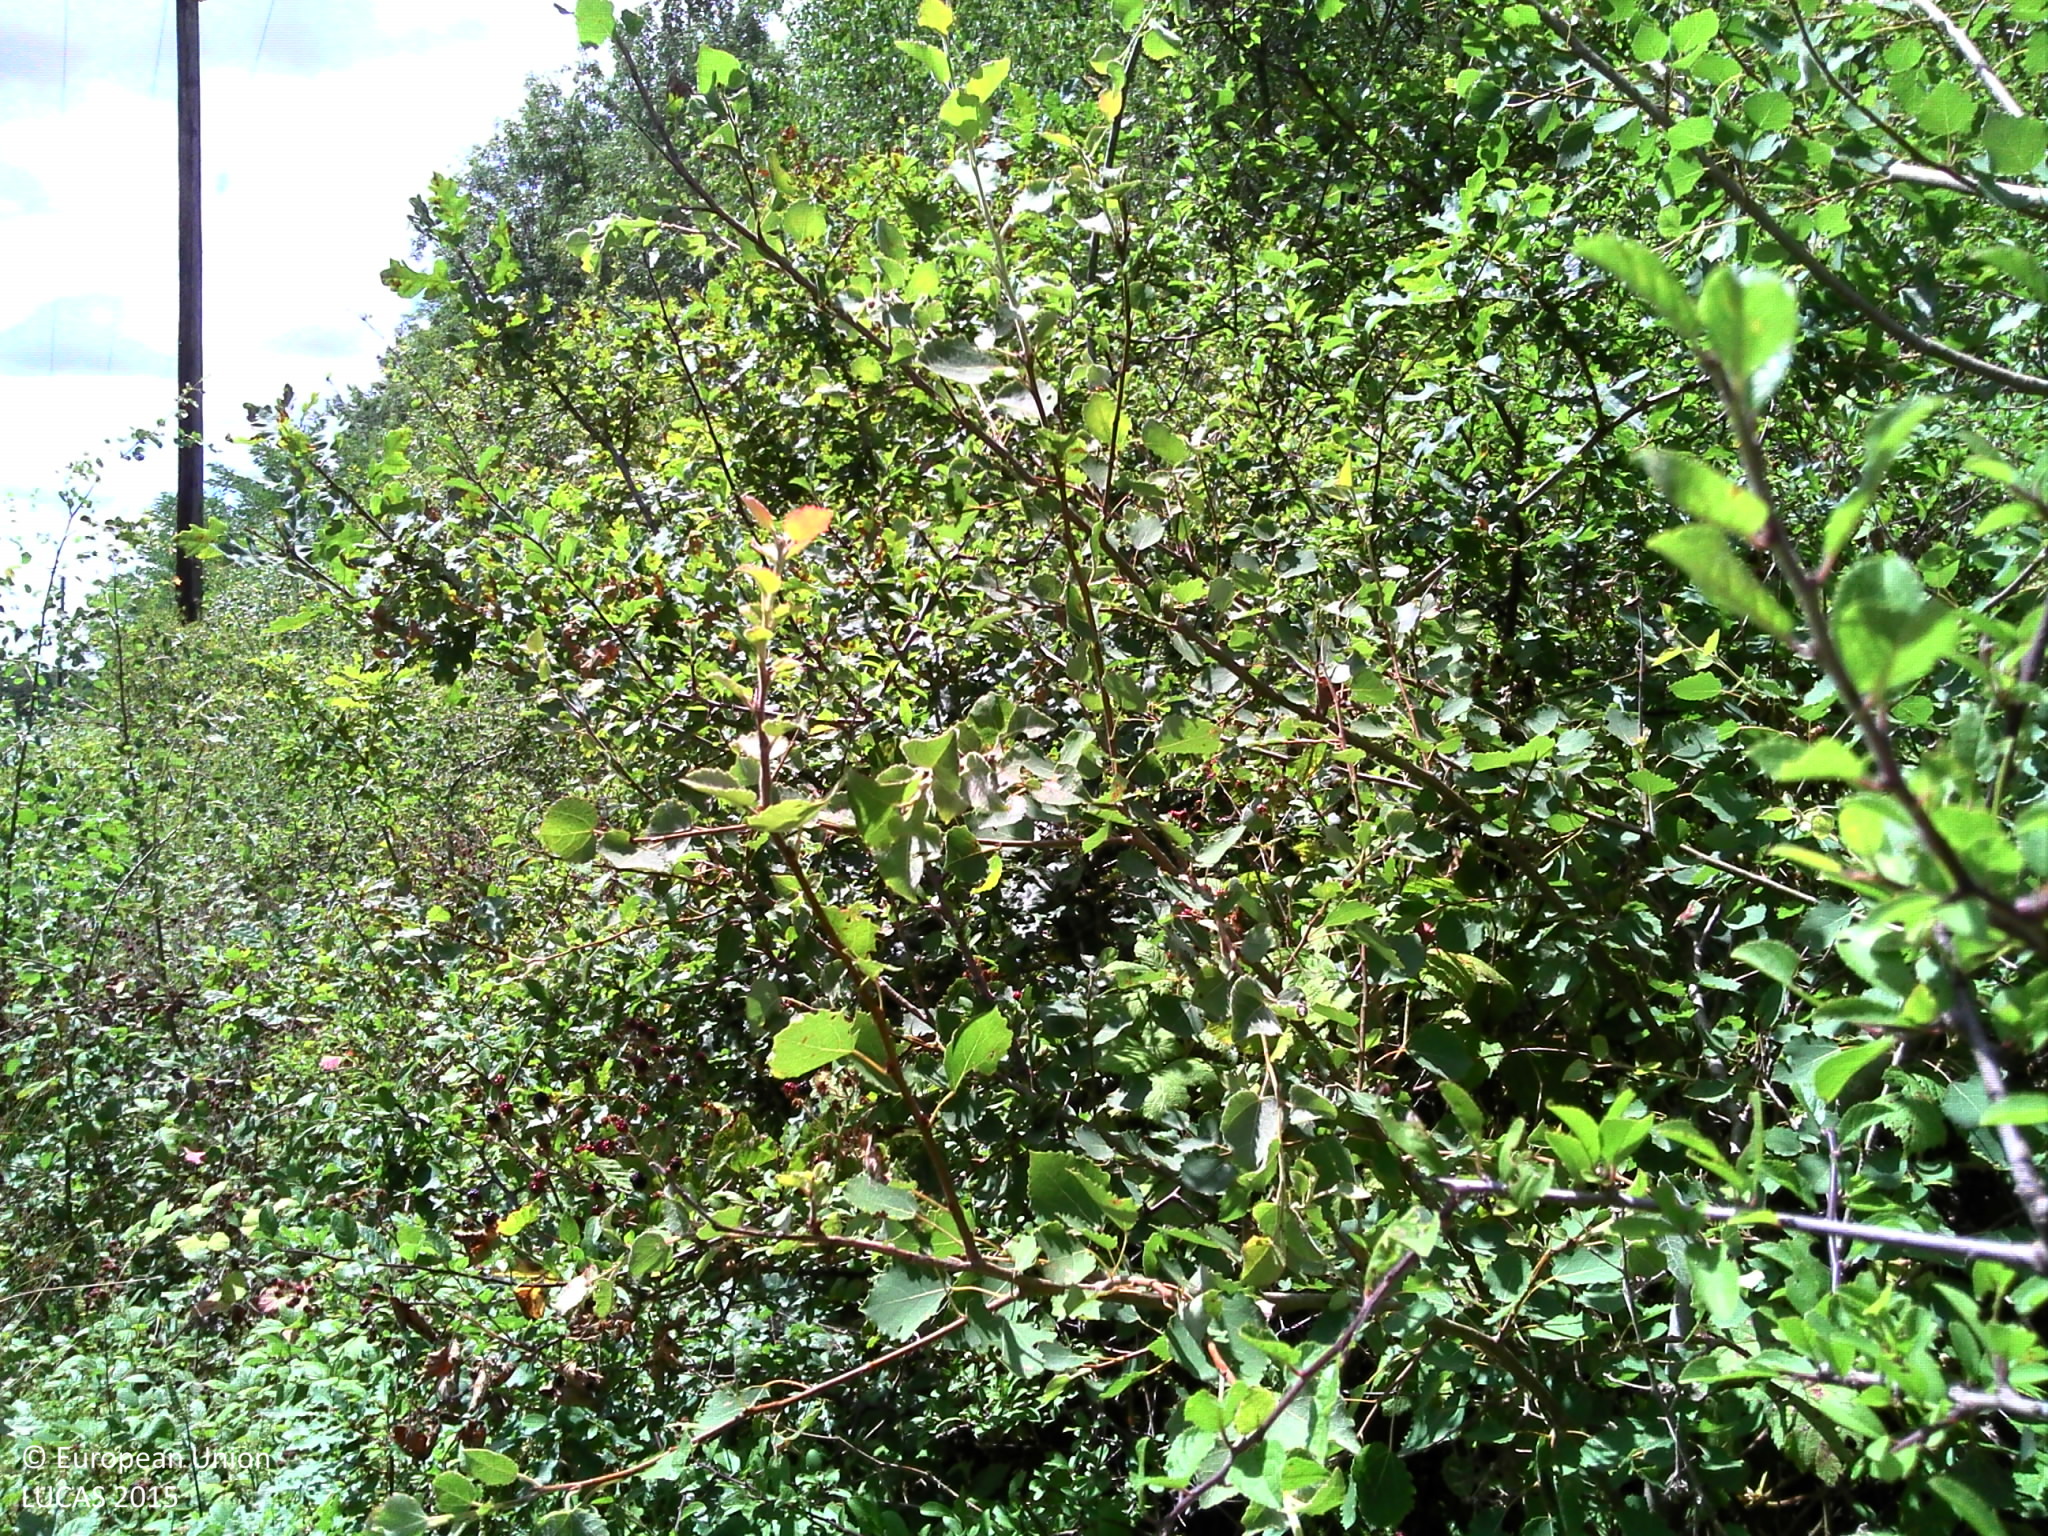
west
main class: Woodland
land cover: Broadleaved woodland
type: mesophytic deciduous forest
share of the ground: > 75 %
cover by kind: broadleaved forest trees 90 %, herbaceous plants 5 %, lichens and mosses 5 %
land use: Semi-natural and natural areas not in use
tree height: > 5 m
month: July
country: FR
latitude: 47.5589
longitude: 3.1503
